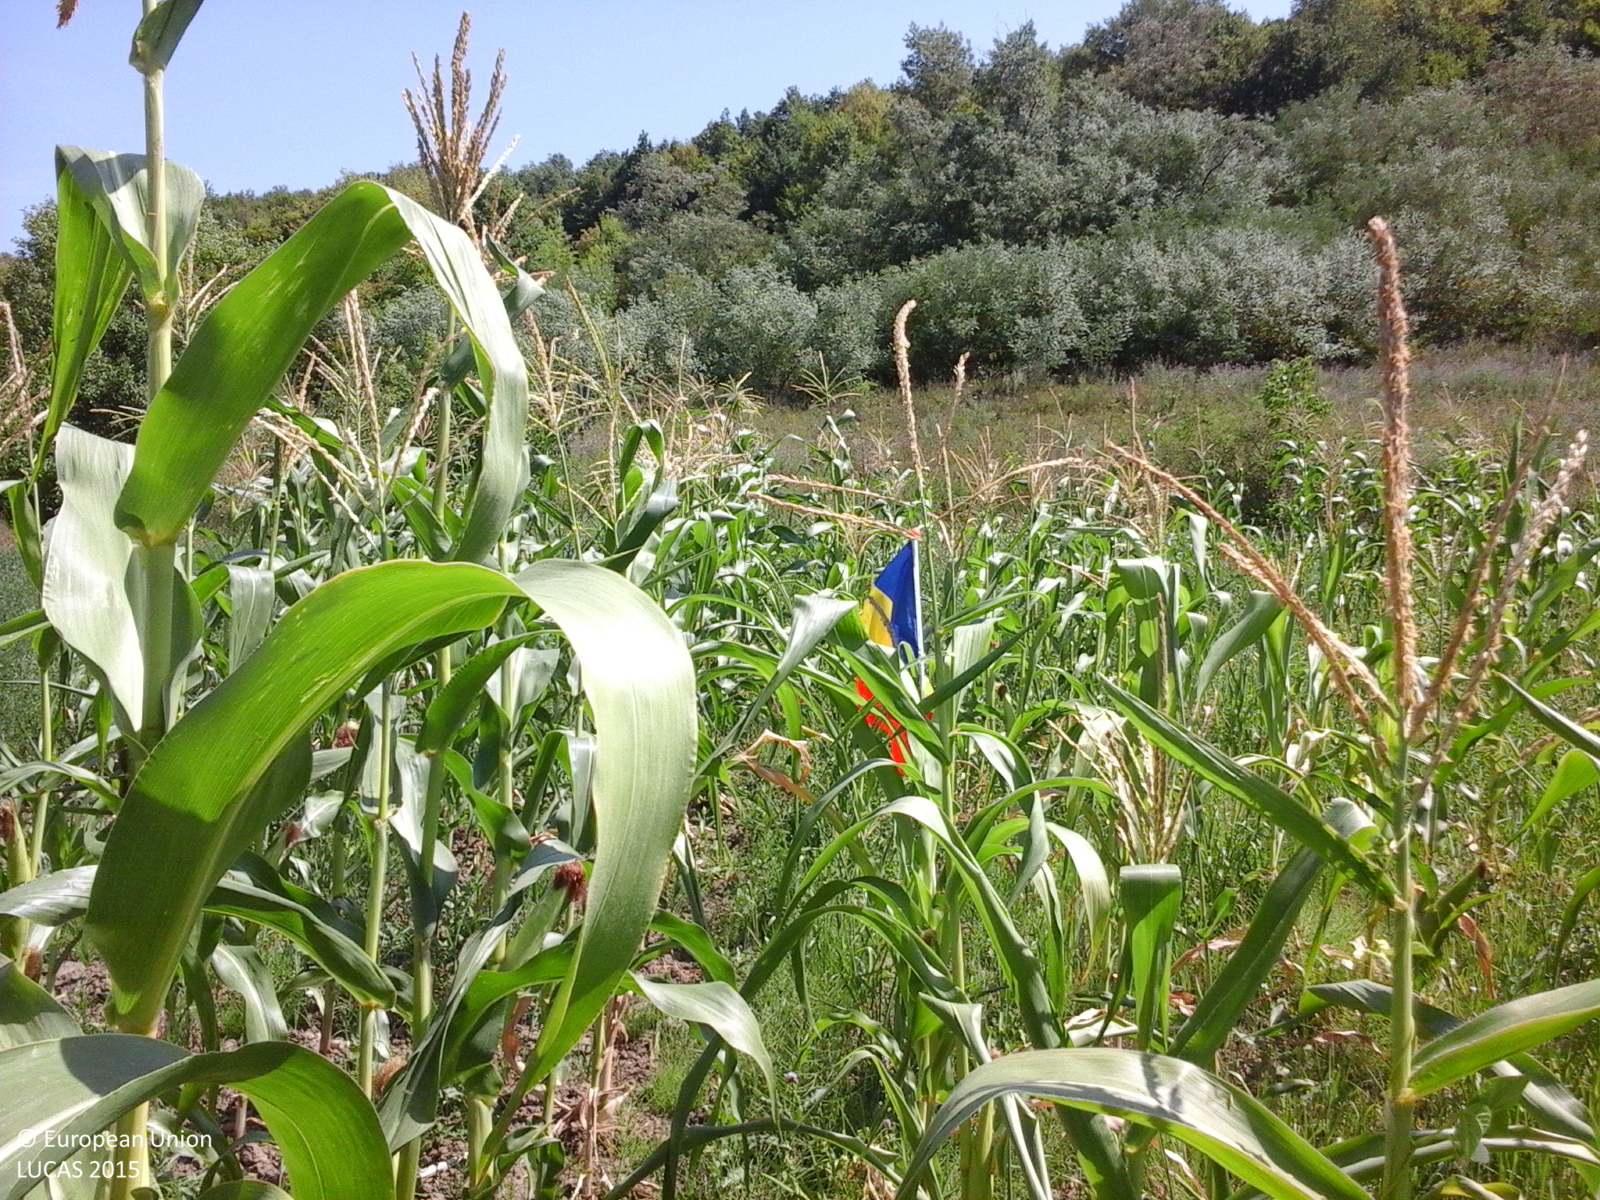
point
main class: Cropland
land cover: Maize
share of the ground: > 75 %
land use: Agriculture (excluding fallow land and kitchen gardens)
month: July
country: RO
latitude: 46.5063
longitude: 27.2128
